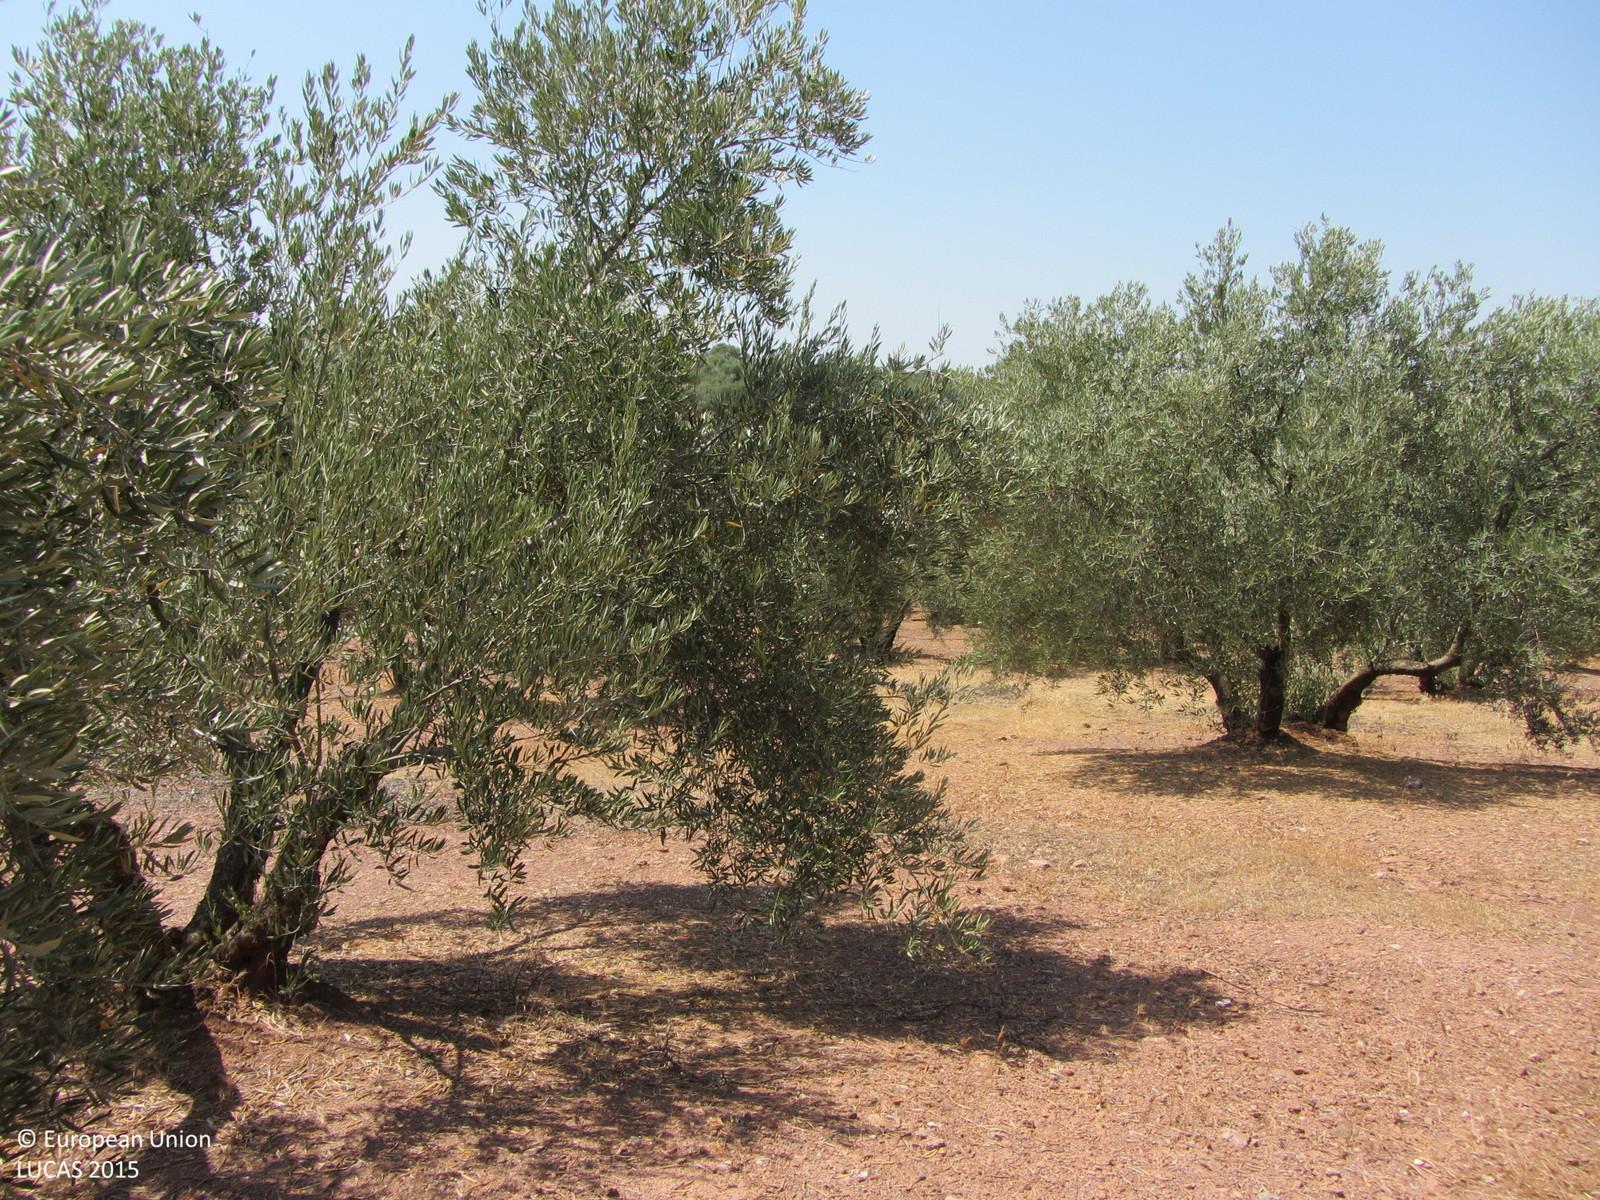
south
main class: Cropland
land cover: Olive groves
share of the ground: 25 - 50 %
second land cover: Other bare soil
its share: > 75 %
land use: Agriculture (excluding fallow land and kitchen gardens)
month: June
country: ES
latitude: 38.2221
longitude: -3.4251
